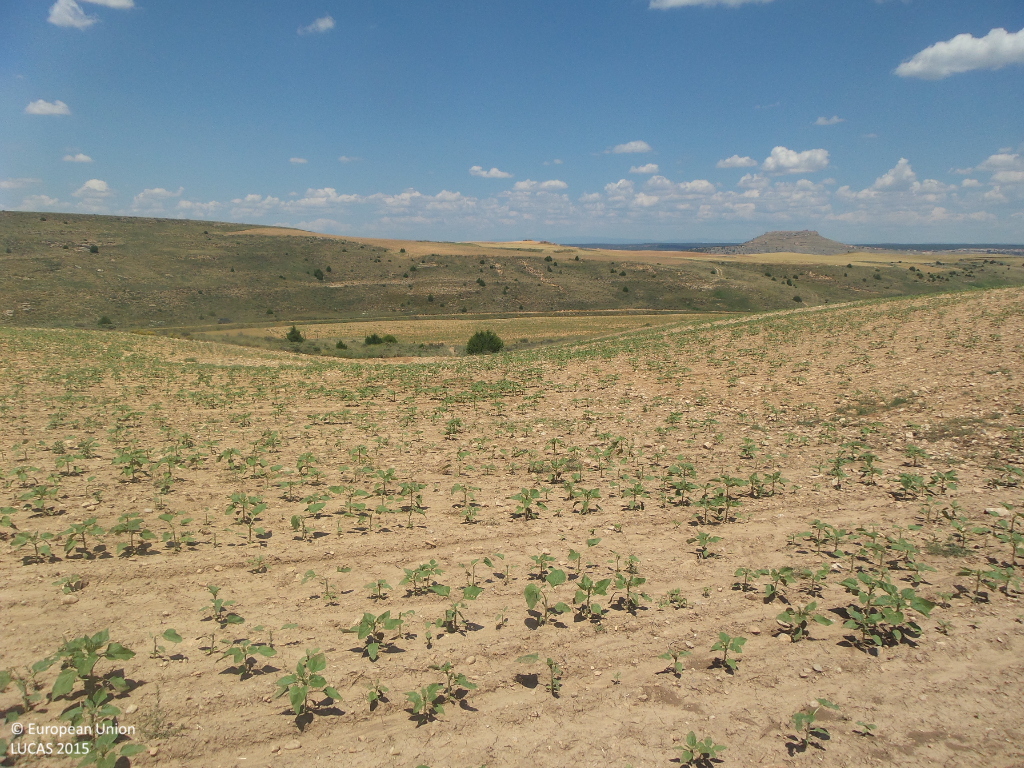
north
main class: Cropland
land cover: Sunflower
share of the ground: 10 - 25 %
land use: Agriculture (excluding fallow land and kitchen gardens)
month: June
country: ES
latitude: 41.4610
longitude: -3.0314
